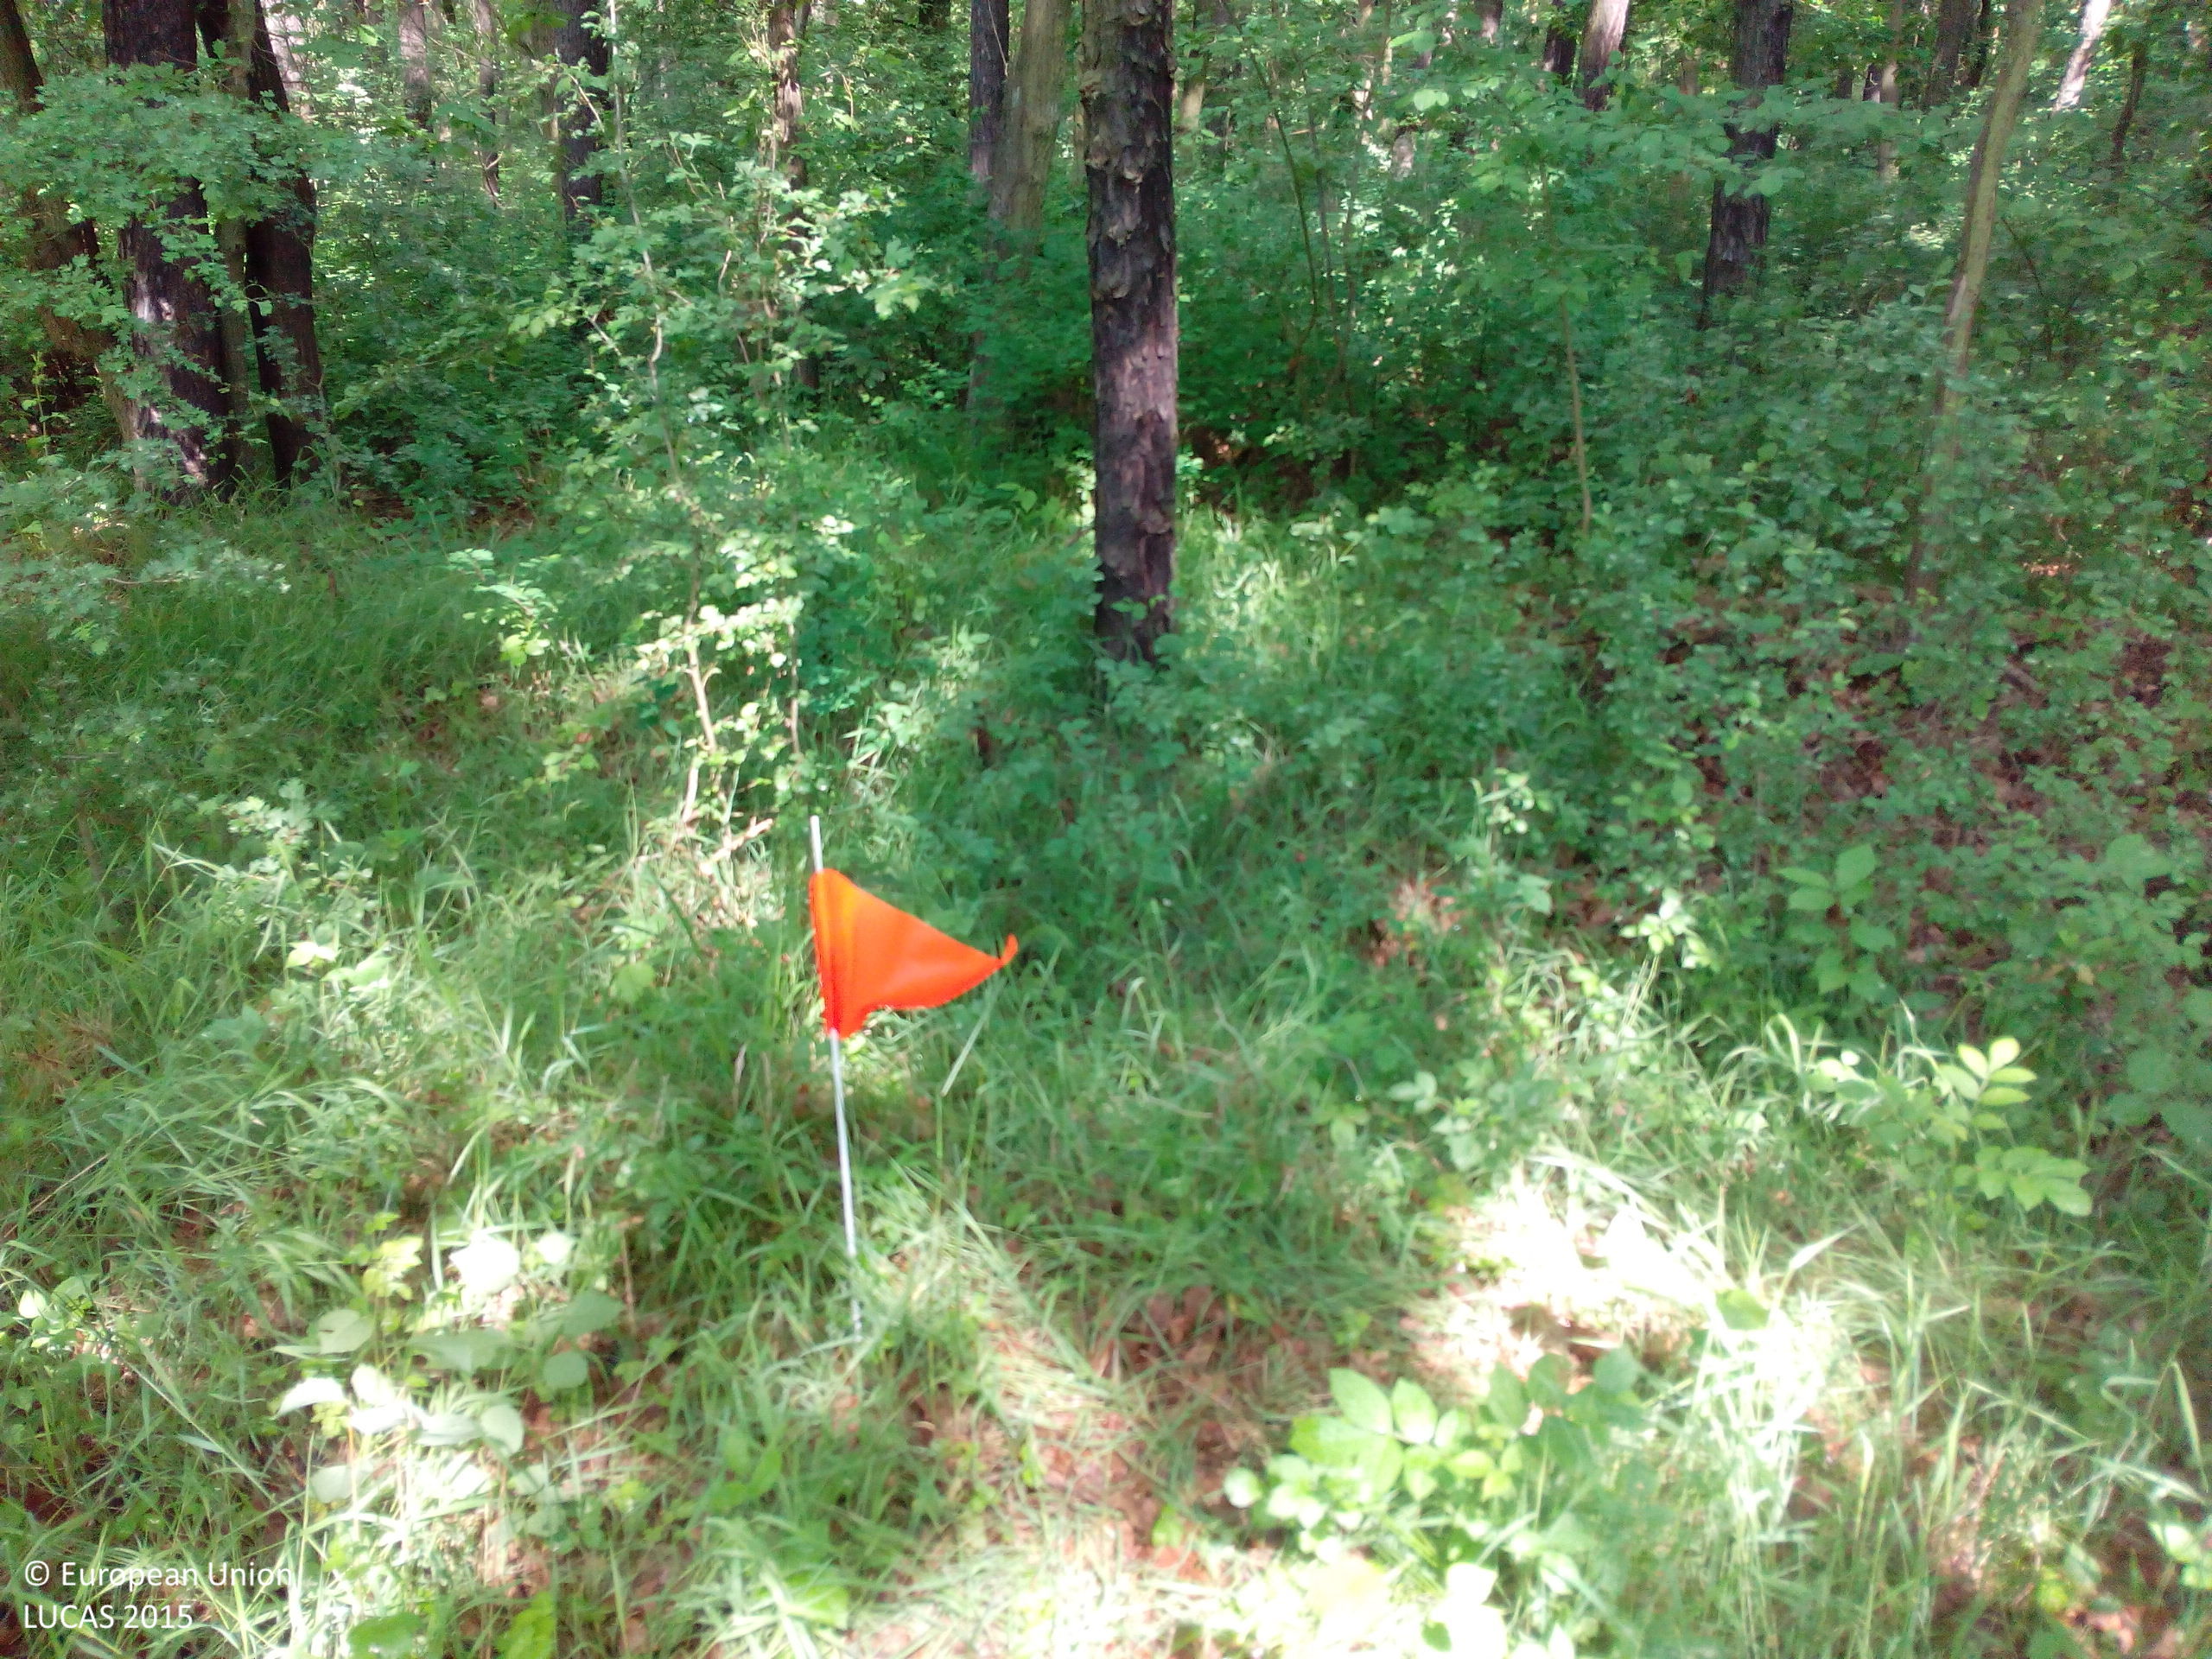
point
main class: Woodland
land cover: Pine dominated mixed woodland
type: hemiboreal forest and nemoral coniferous forest and mixed broadleaved-coniferous forest
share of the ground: > 75 %
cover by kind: coniferous forest trees 55 %, broadleaved forest trees 40 %, shrubs 5 %
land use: Forestry
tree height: > 5 m
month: May
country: DE
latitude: 51.6882
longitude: 12.3865
